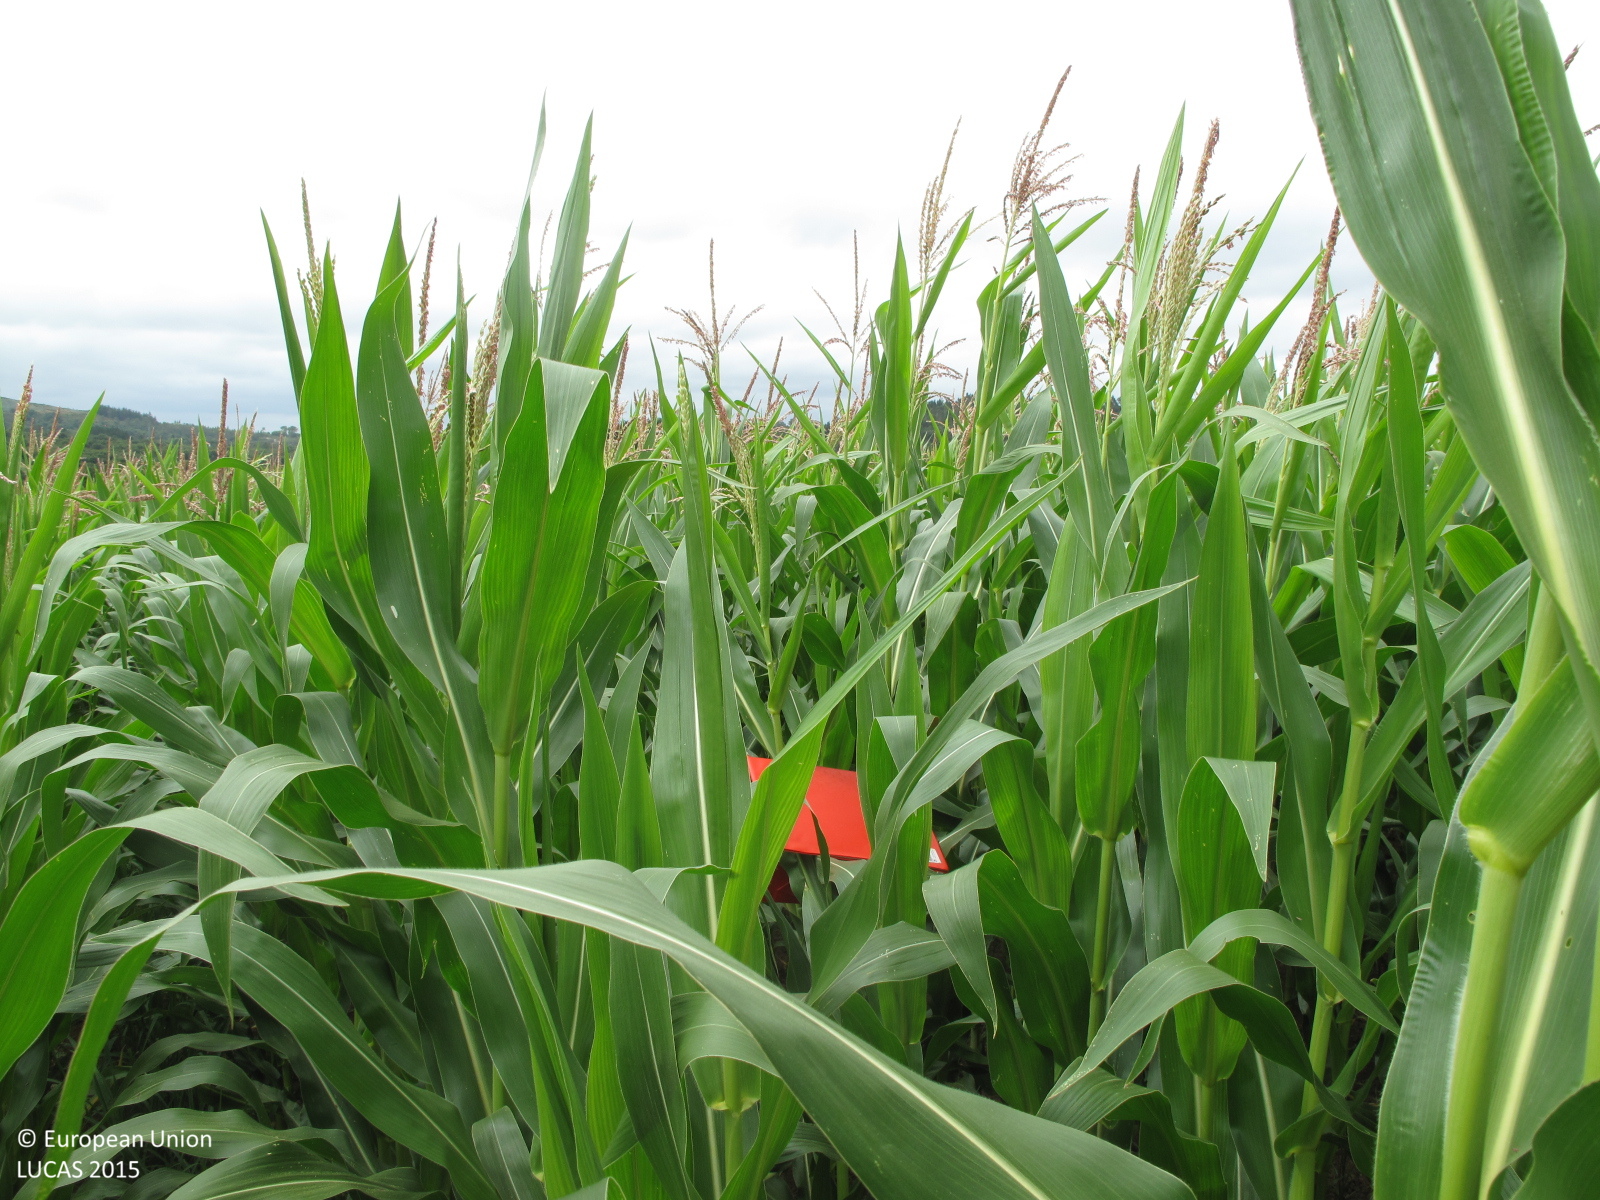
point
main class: Cropland
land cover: Maize
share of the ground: > 75 %
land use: Agriculture (excluding fallow land and kitchen gardens)
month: July
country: ES
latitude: 42.9156
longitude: -8.4655
